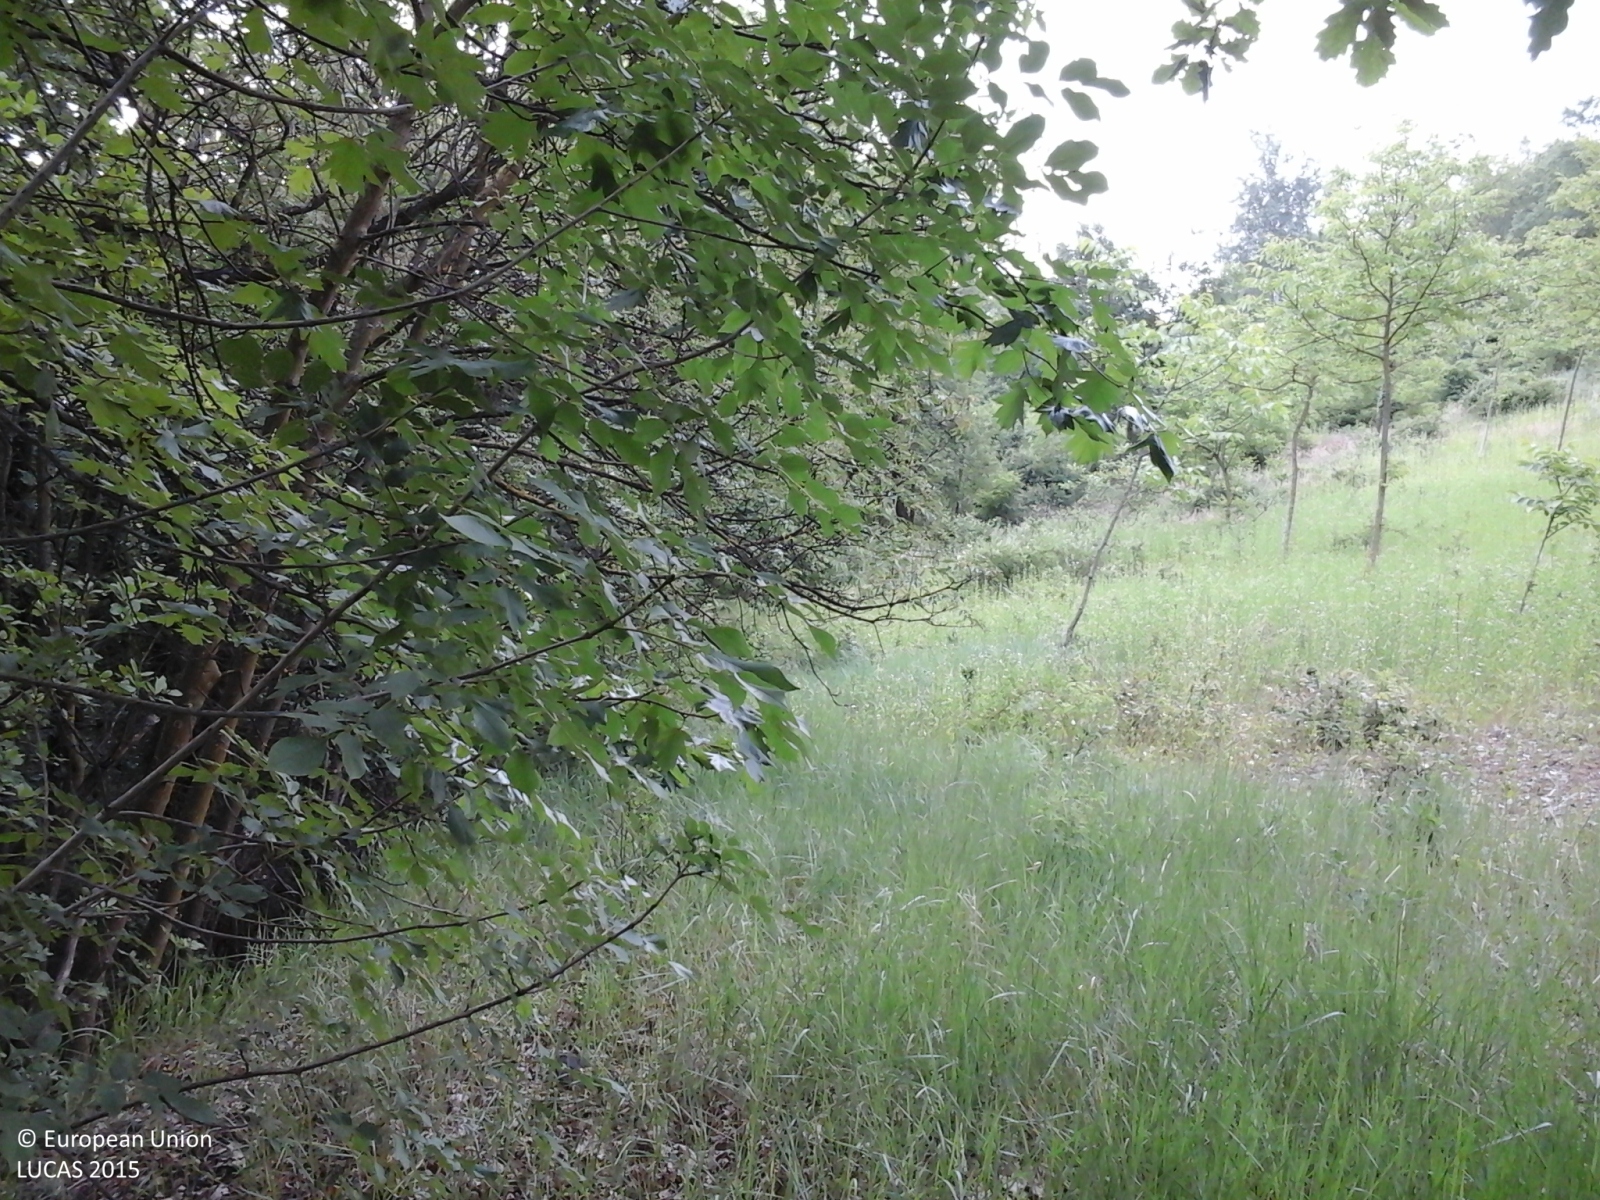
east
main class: Woodland
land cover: Broadleaved woodland
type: thermophilous deciduous forest
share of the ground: > 75 %
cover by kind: broadleaved forest trees 90 %, shrubs 10 %
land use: Forestry
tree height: > 5 m
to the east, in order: Broadleaved woodland; Tracks; Broadleaved woodland
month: May
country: IT
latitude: 44.6810
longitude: 8.4011
